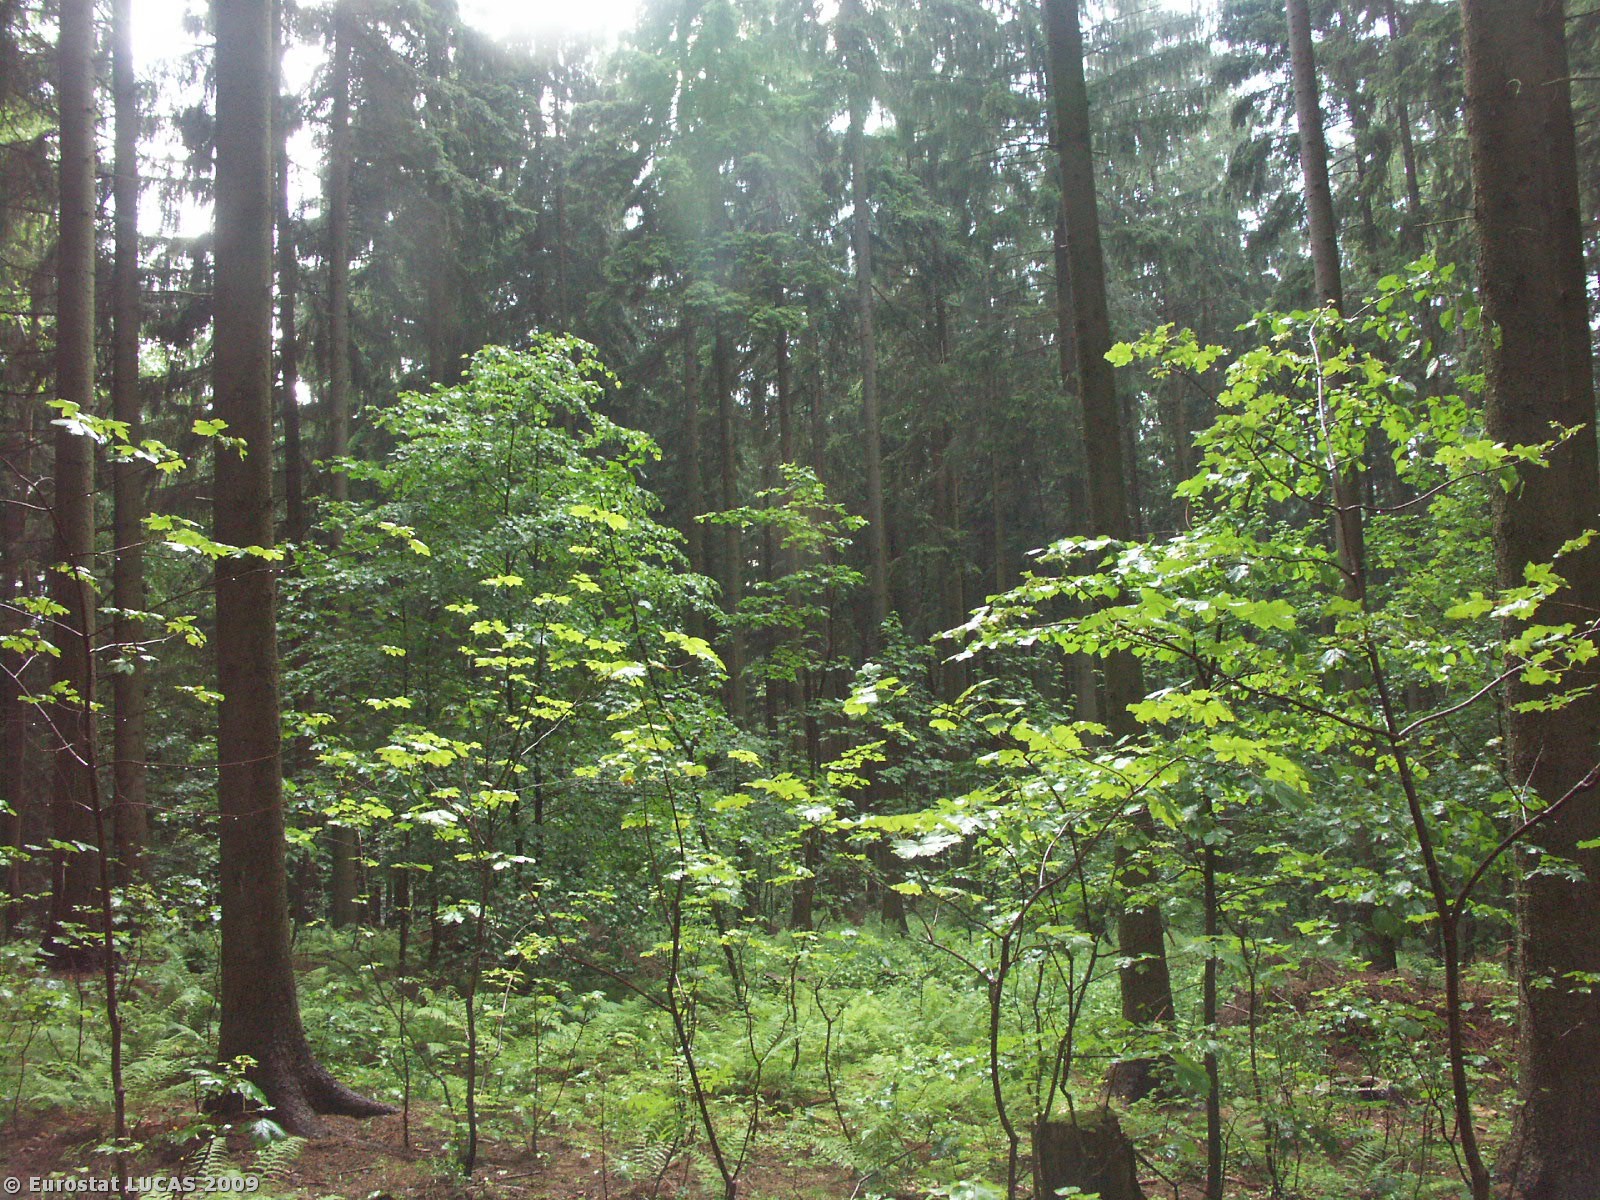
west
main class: Woodland
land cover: Coniferous woodland
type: hemiboreal forest and nemoral coniferous forest and mixed broadleaved-coniferous forest
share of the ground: > 75 %
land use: Forestry
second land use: Nature reserves
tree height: > 5 m
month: June
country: CZ
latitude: 50.0161
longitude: 17.1138
